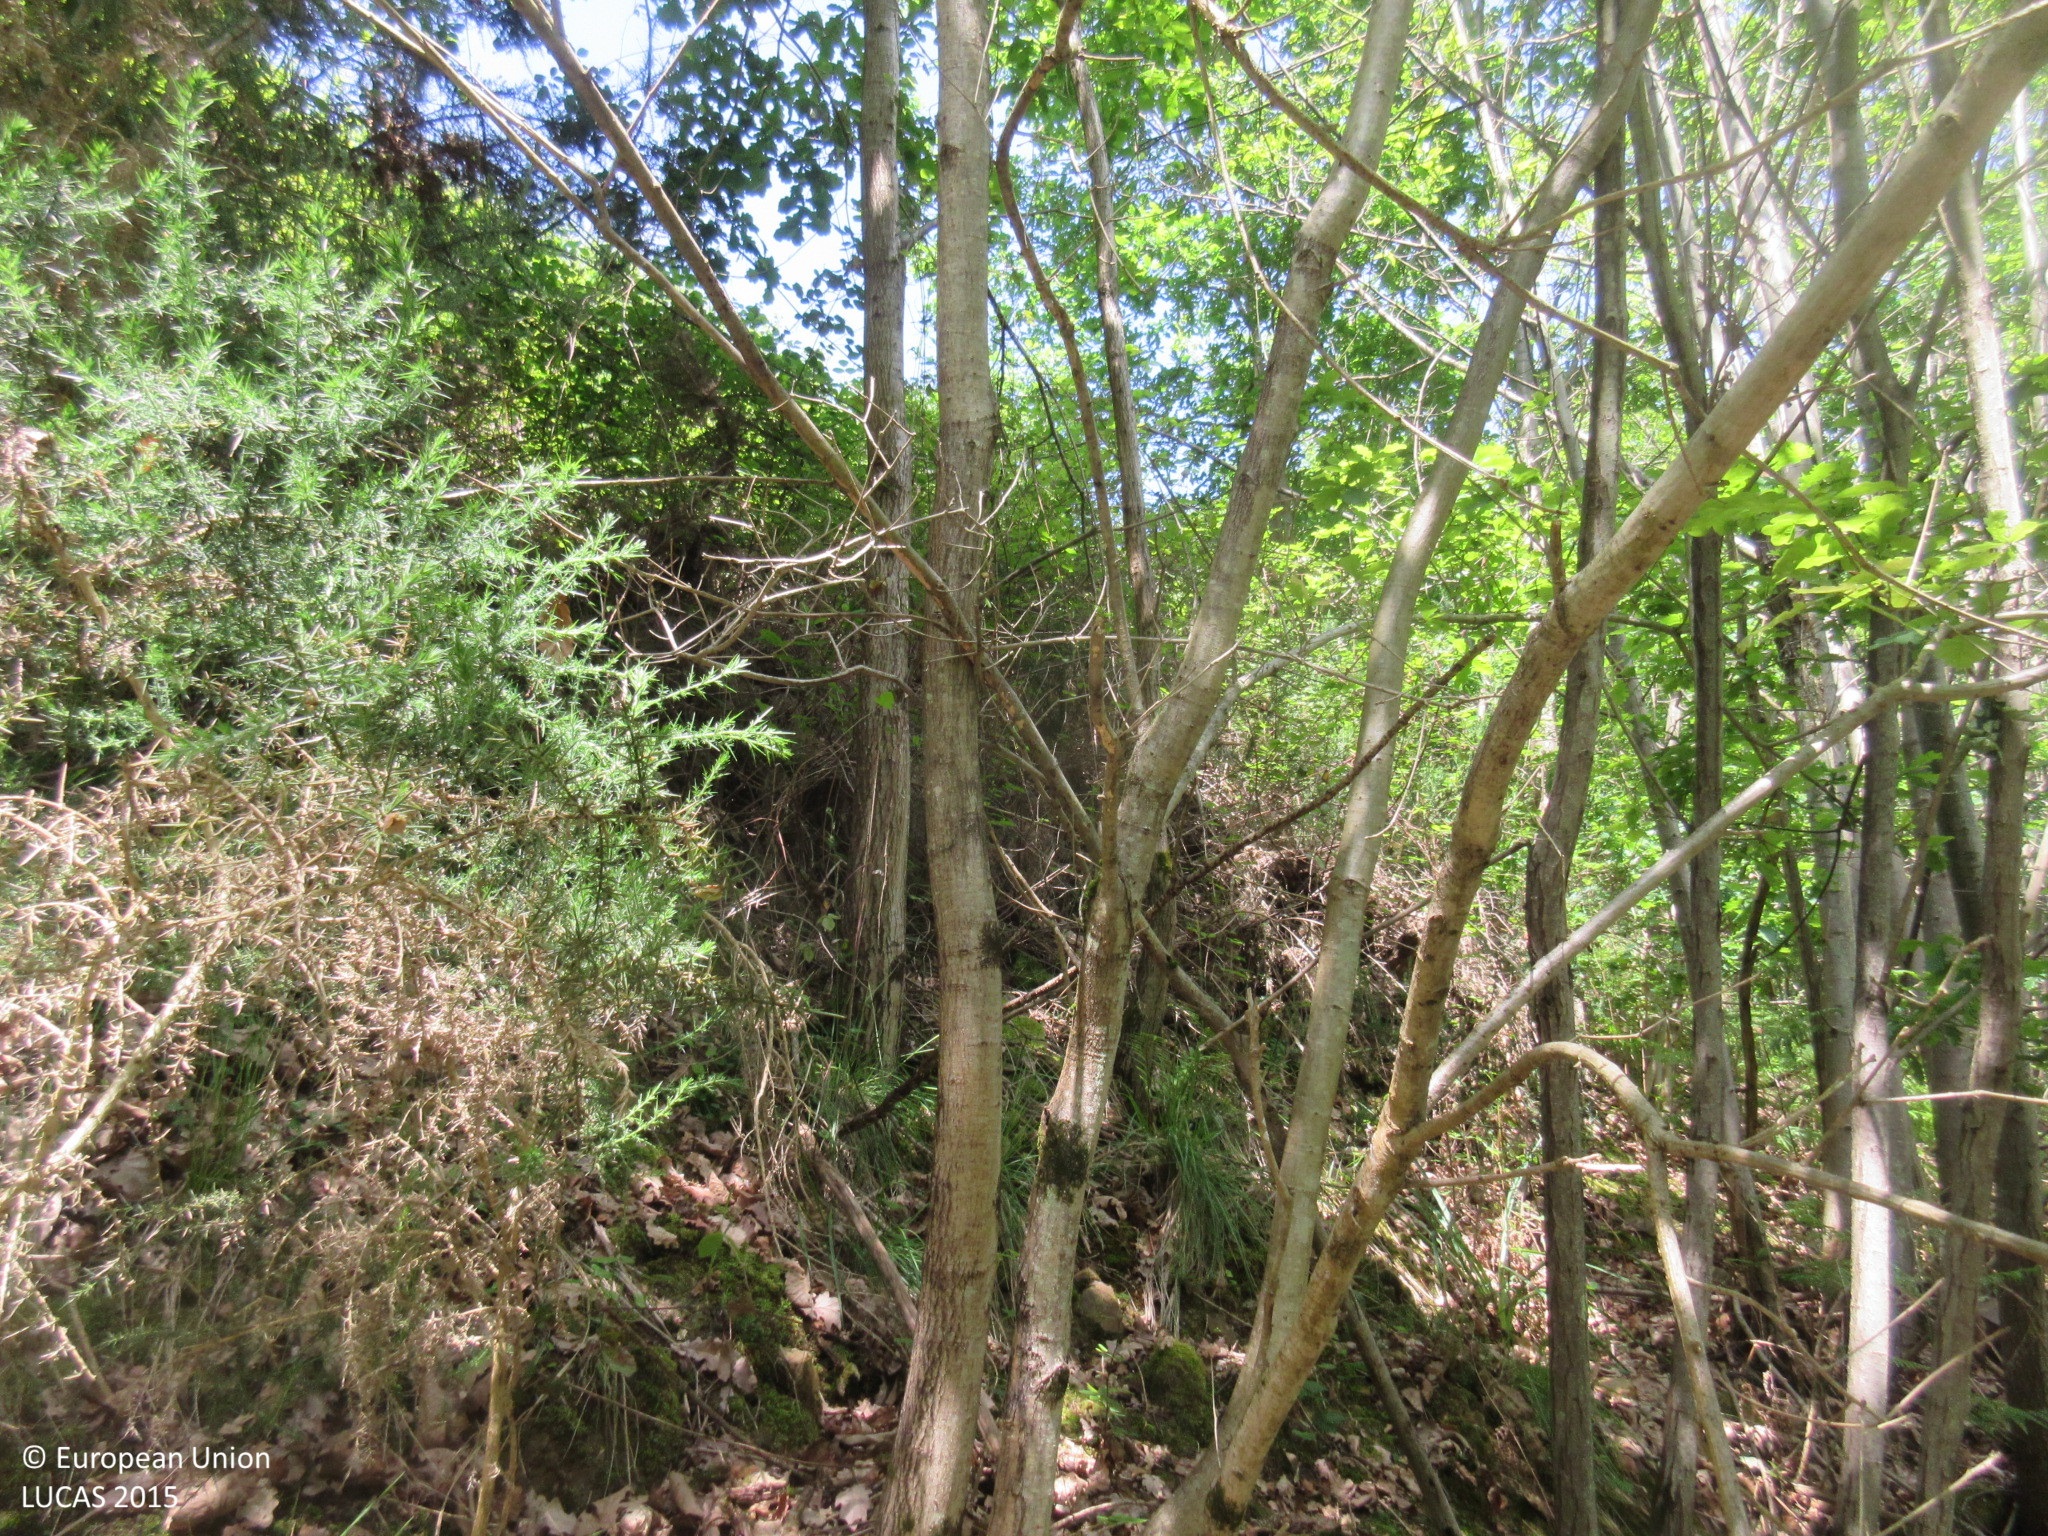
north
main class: Woodland
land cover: Broadleaved woodland
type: acidophilous oak and oak-birch forest
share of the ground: > 75 %
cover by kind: broadleaved forest trees 95 %, shrubs 5 %
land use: Forestry
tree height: > 5 m
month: May
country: ES
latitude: 43.3158
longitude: -5.9080
